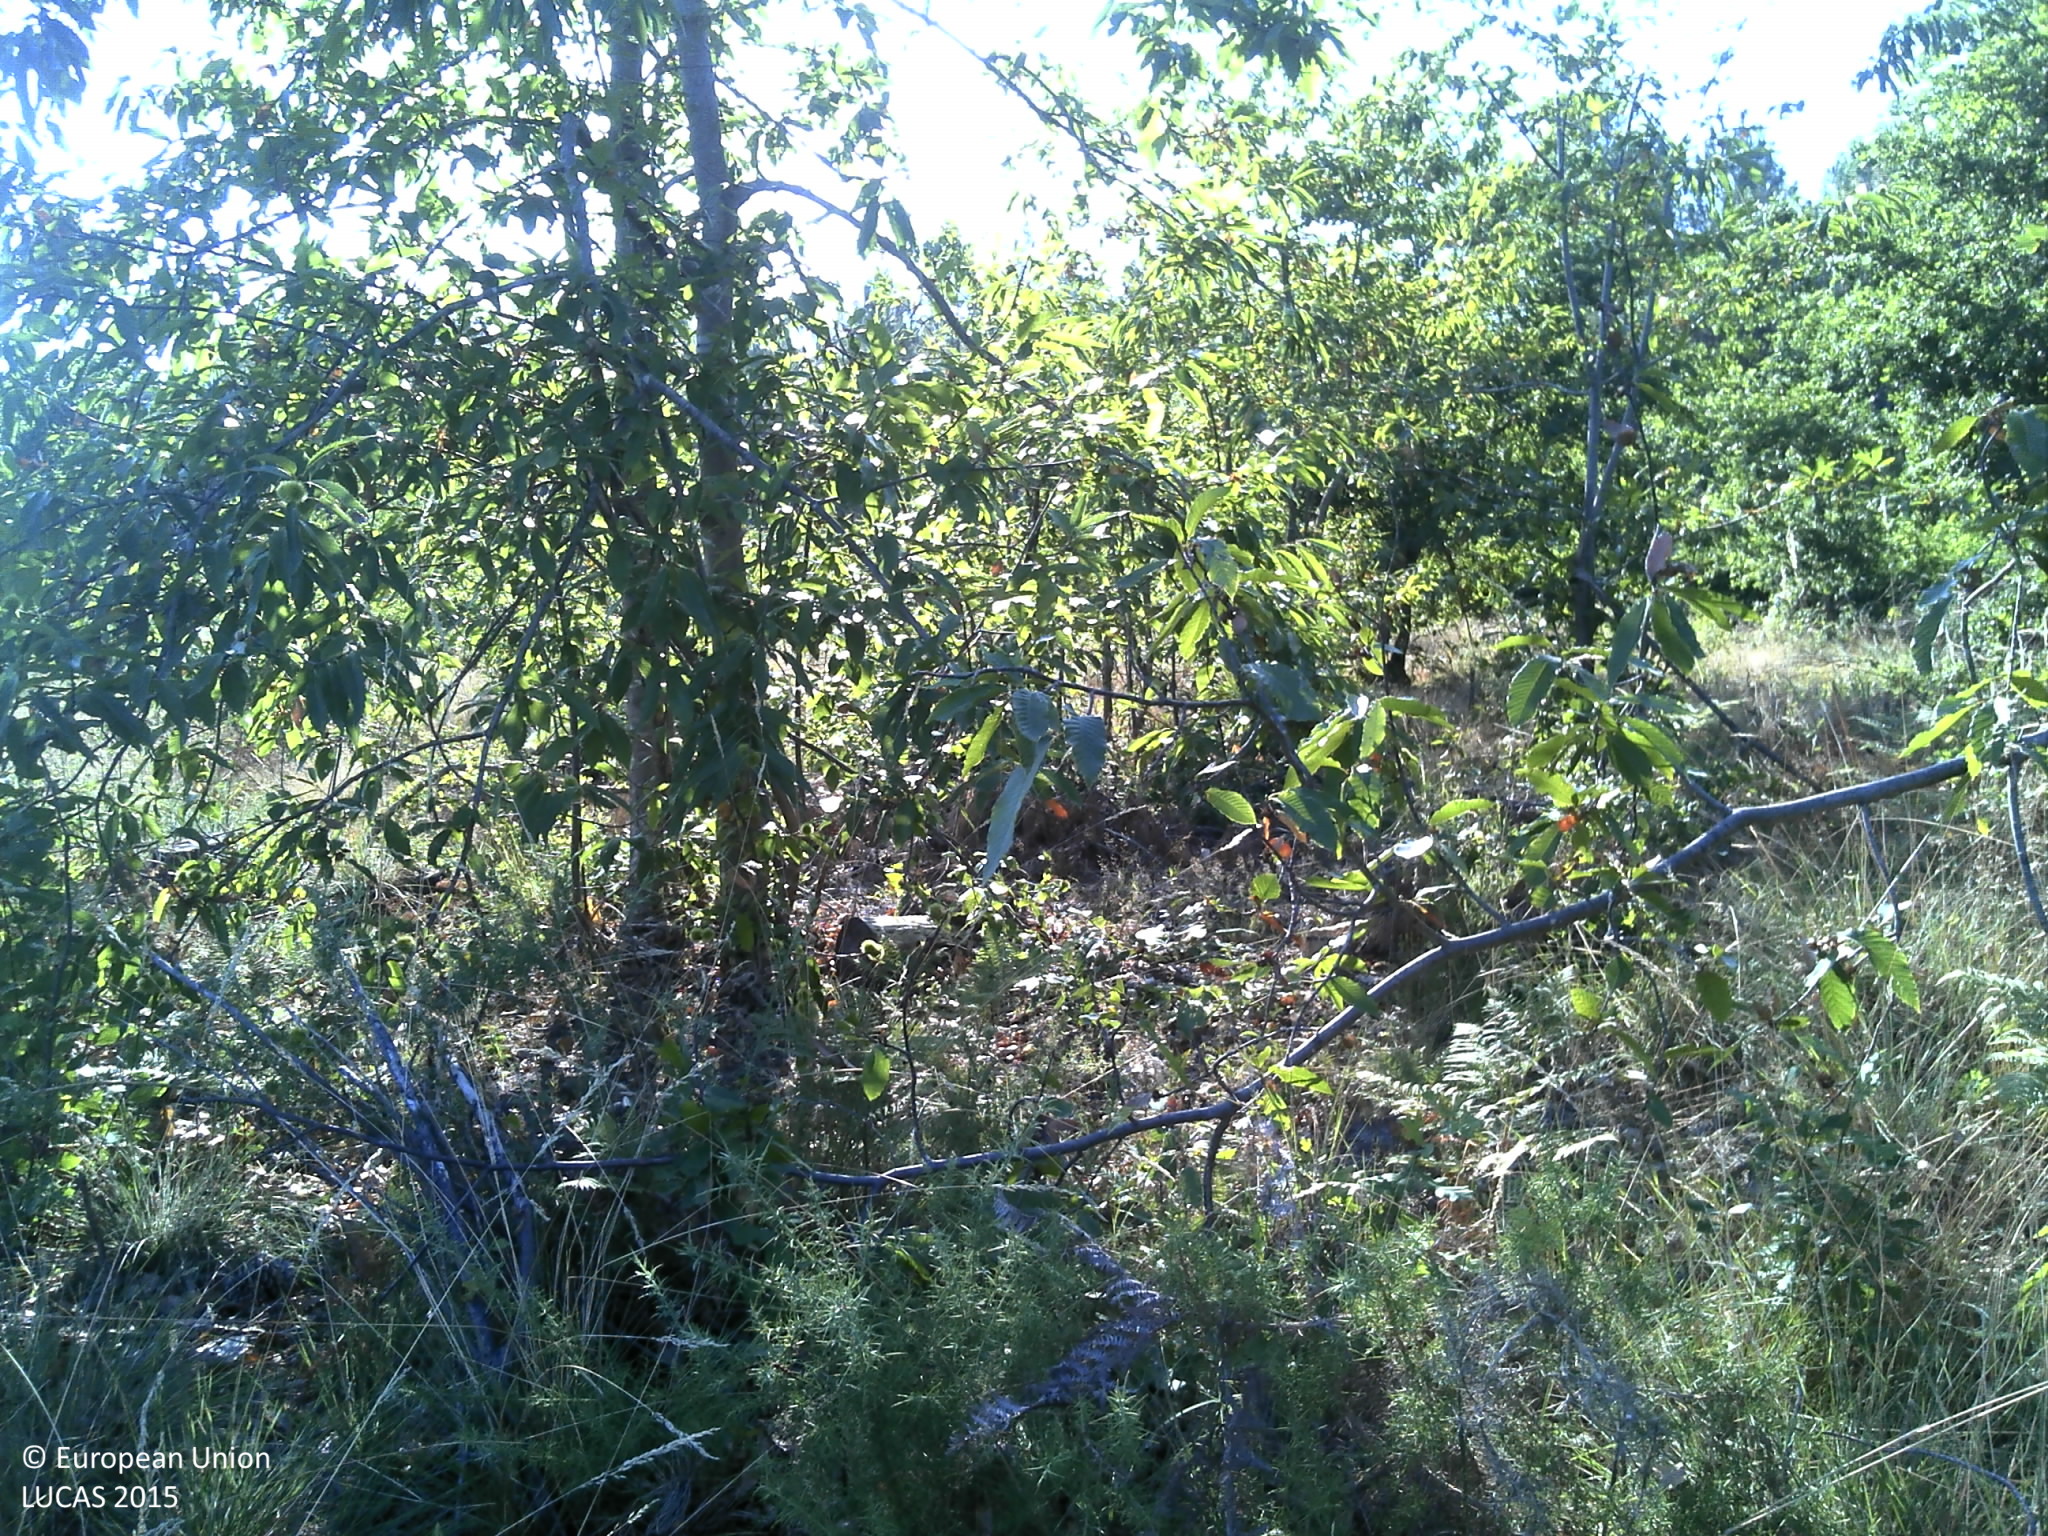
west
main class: Woodland
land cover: Pine dominated mixed woodland
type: coniferous forest of the mediterranean region
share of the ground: 50 - 75 %
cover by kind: broadleaved forest trees 50 %, coniferous forest trees 25 %, shrubs 15 %, herbaceous plants 5 %, lichens and mosses 5 %
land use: Forestry
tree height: < 5 m
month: August
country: FR
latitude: 44.5051
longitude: -0.6964
